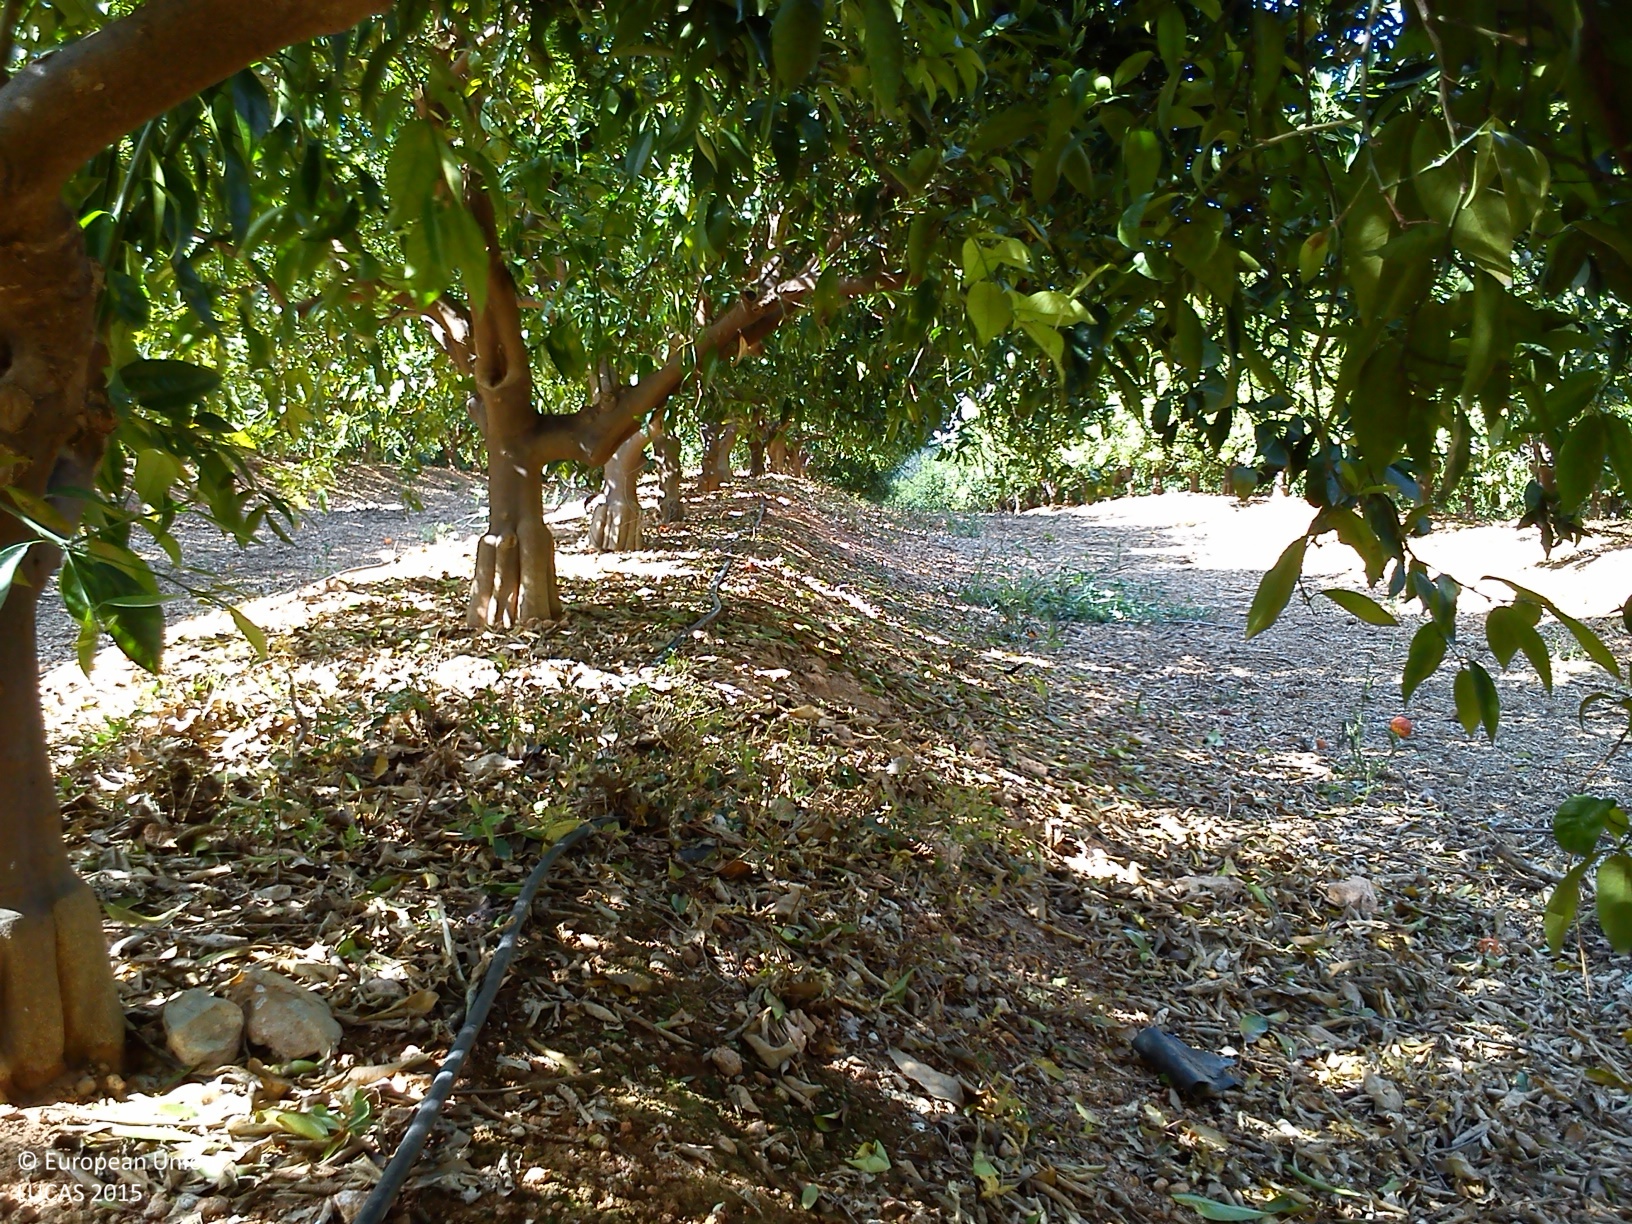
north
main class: Cropland
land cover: Other citrus fruit
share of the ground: 50 - 75 %
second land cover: Other bare soil
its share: > 75 %
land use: Agriculture (excluding fallow land and kitchen gardens)
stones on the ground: 10 - 25 %
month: April
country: ES
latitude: 39.5226
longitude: -0.6430
